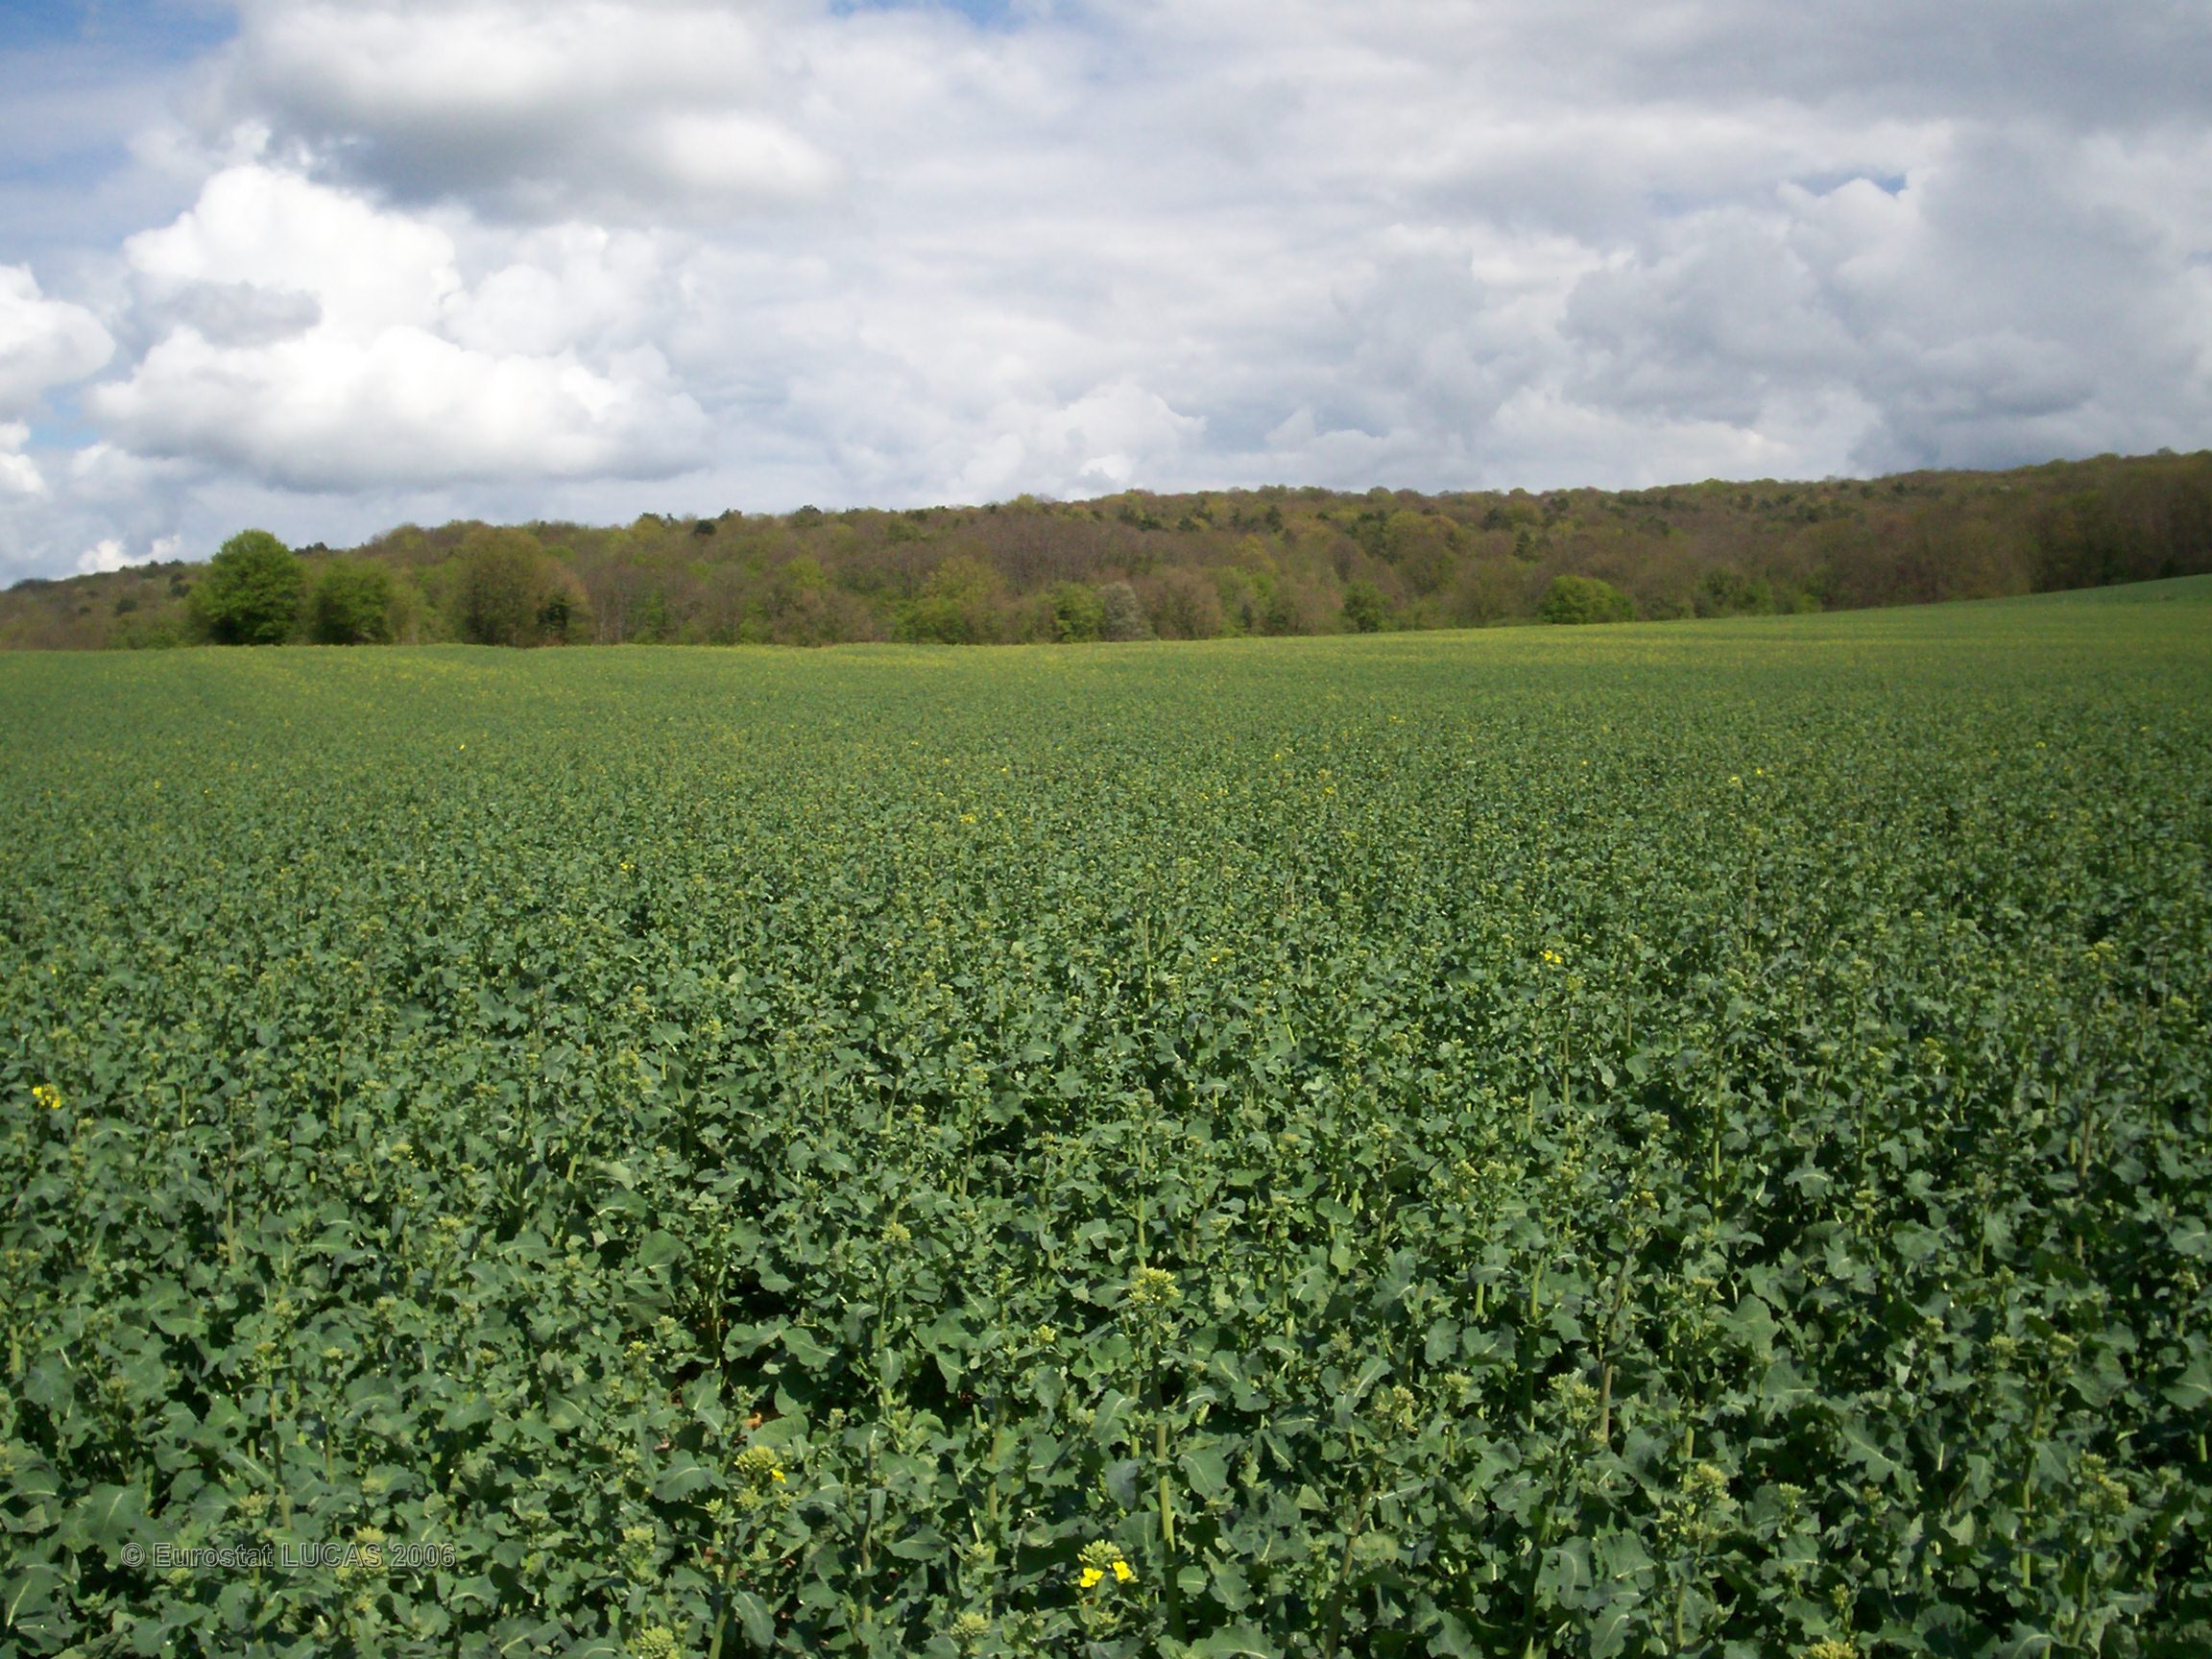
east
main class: Cropland
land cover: Rape and turnip rape
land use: Agriculture (excluding fallow land and kitchen gardens)
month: April
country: FR
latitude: 47.5413
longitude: 6.0821
